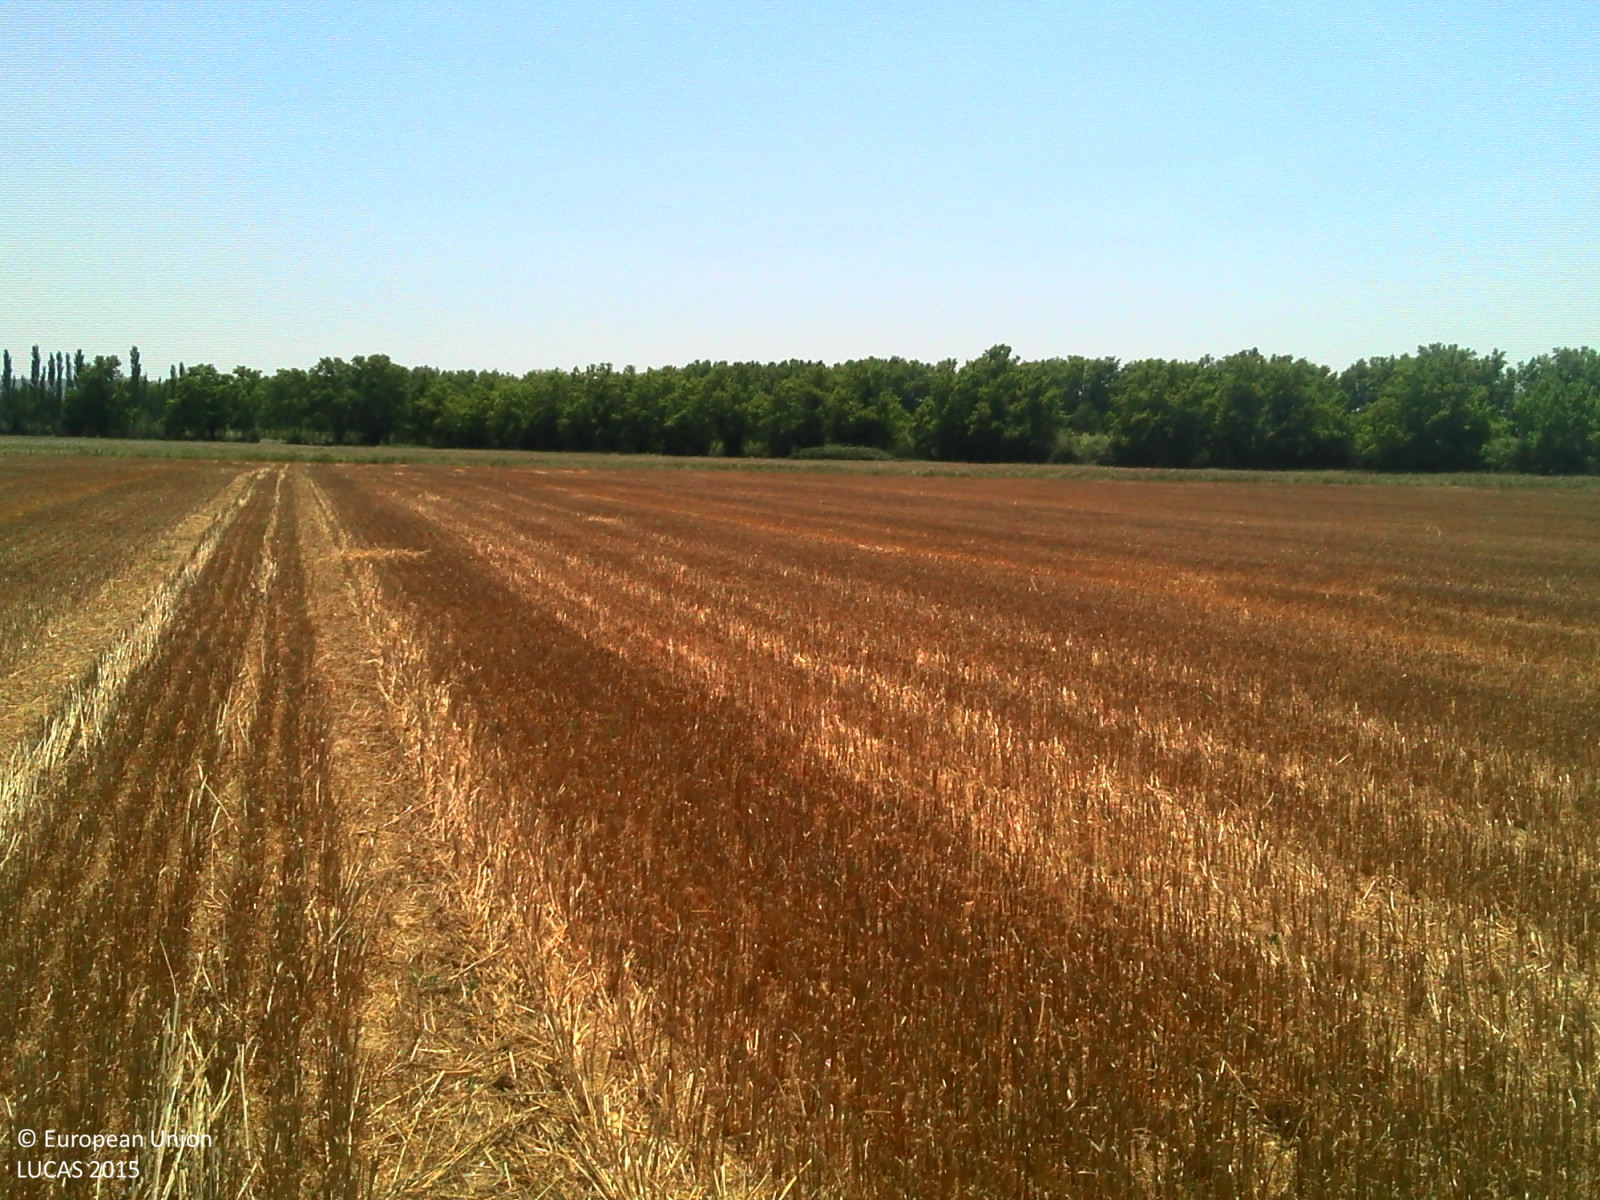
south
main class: Cropland
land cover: Durum wheat
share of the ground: > 75 %
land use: Agriculture (excluding fallow land and kitchen gardens)
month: July
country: FR
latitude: 43.8380
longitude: 4.7480
